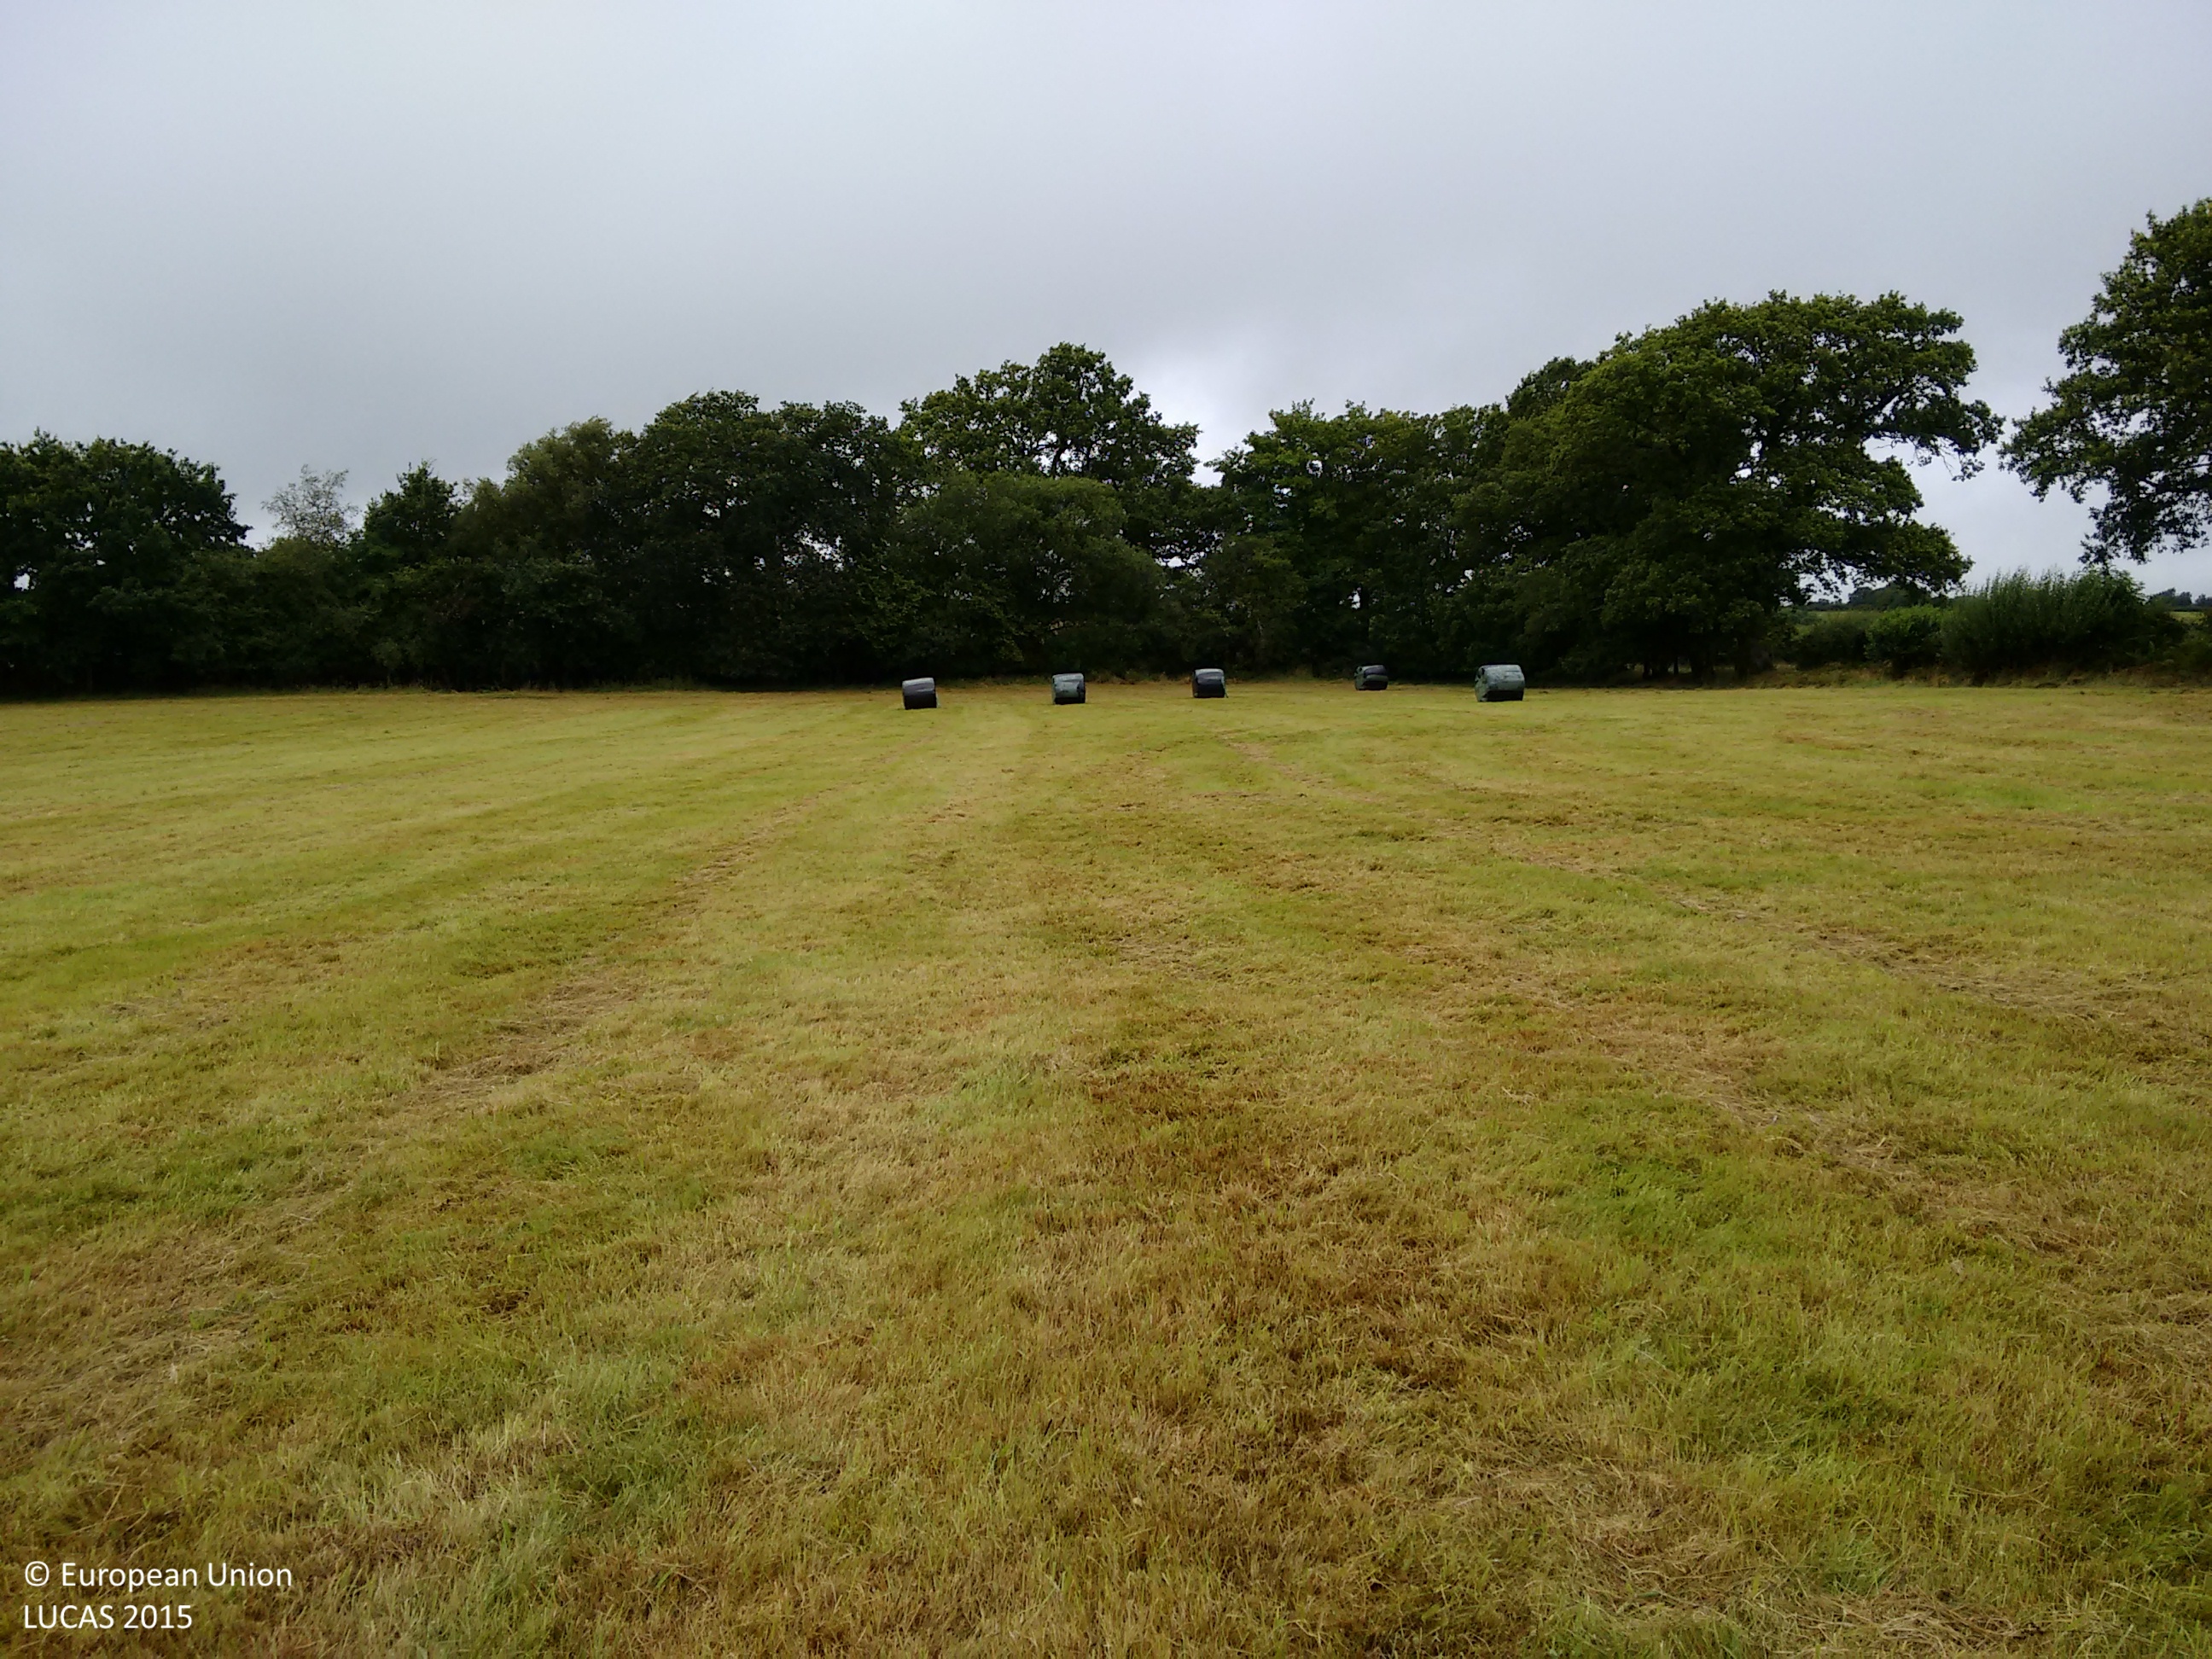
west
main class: Grassland
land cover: Grassland without tree/shrub cover
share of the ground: > 75 %
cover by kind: herbaceous plants 100 %
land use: Agriculture (excluding fallow land and kitchen gardens)
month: August
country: GB
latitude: 51.9034
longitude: -4.0339
